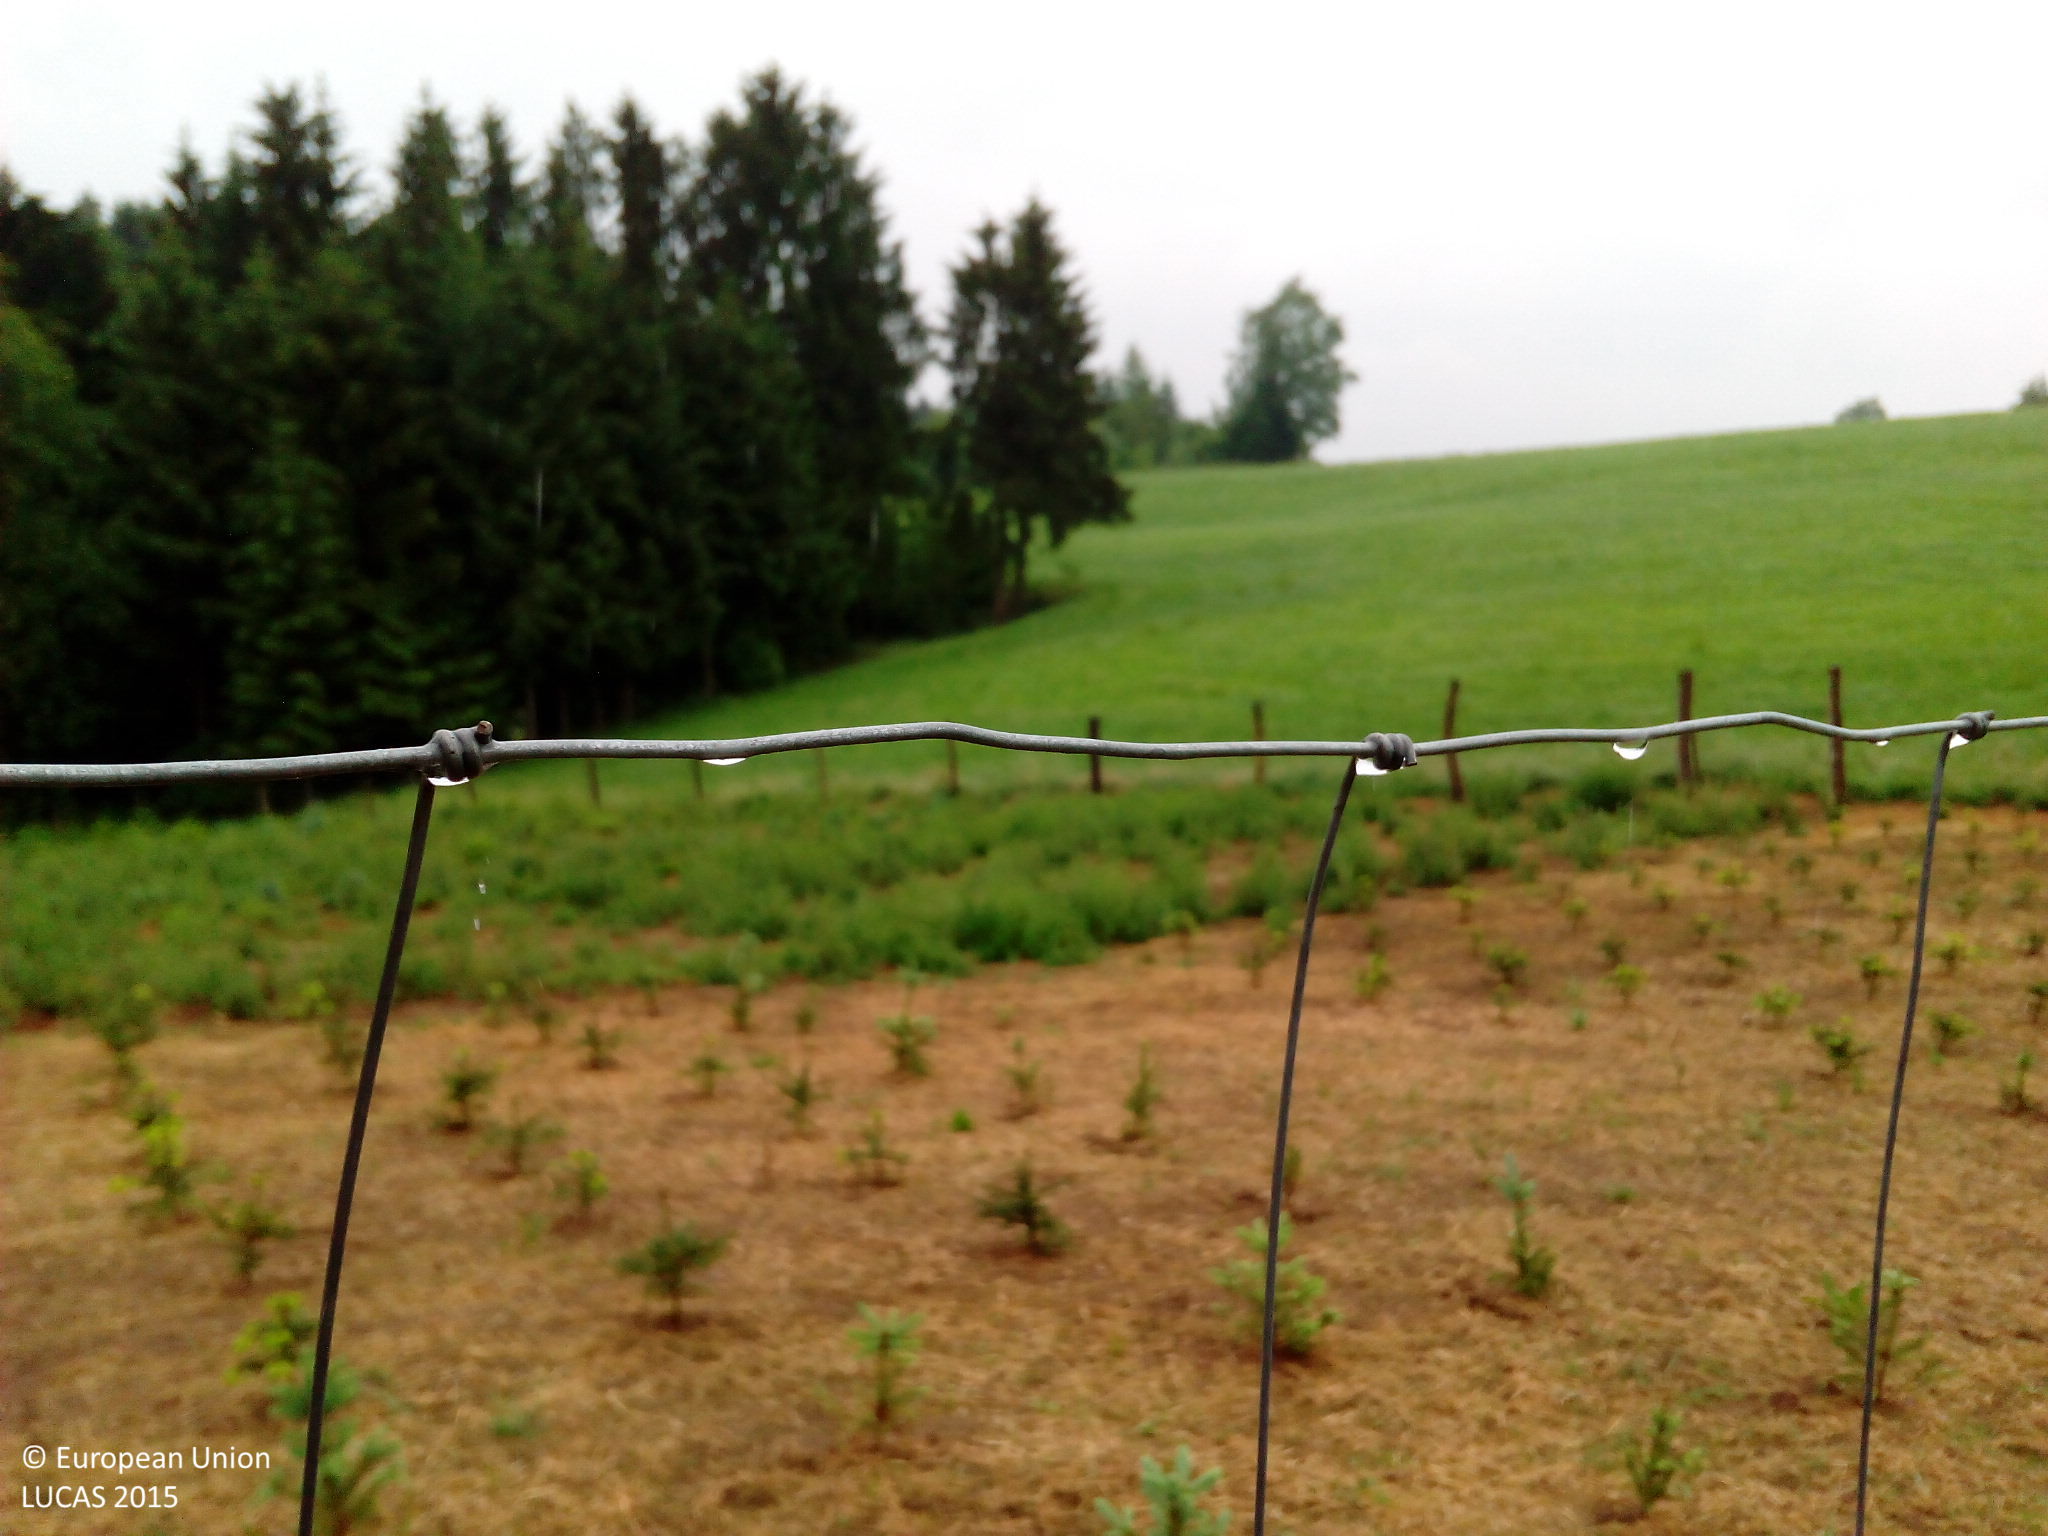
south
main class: Cropland
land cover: Nurseries
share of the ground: 25 - 50 %
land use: Forestry
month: June
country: DE
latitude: 48.8528
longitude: 9.6867
